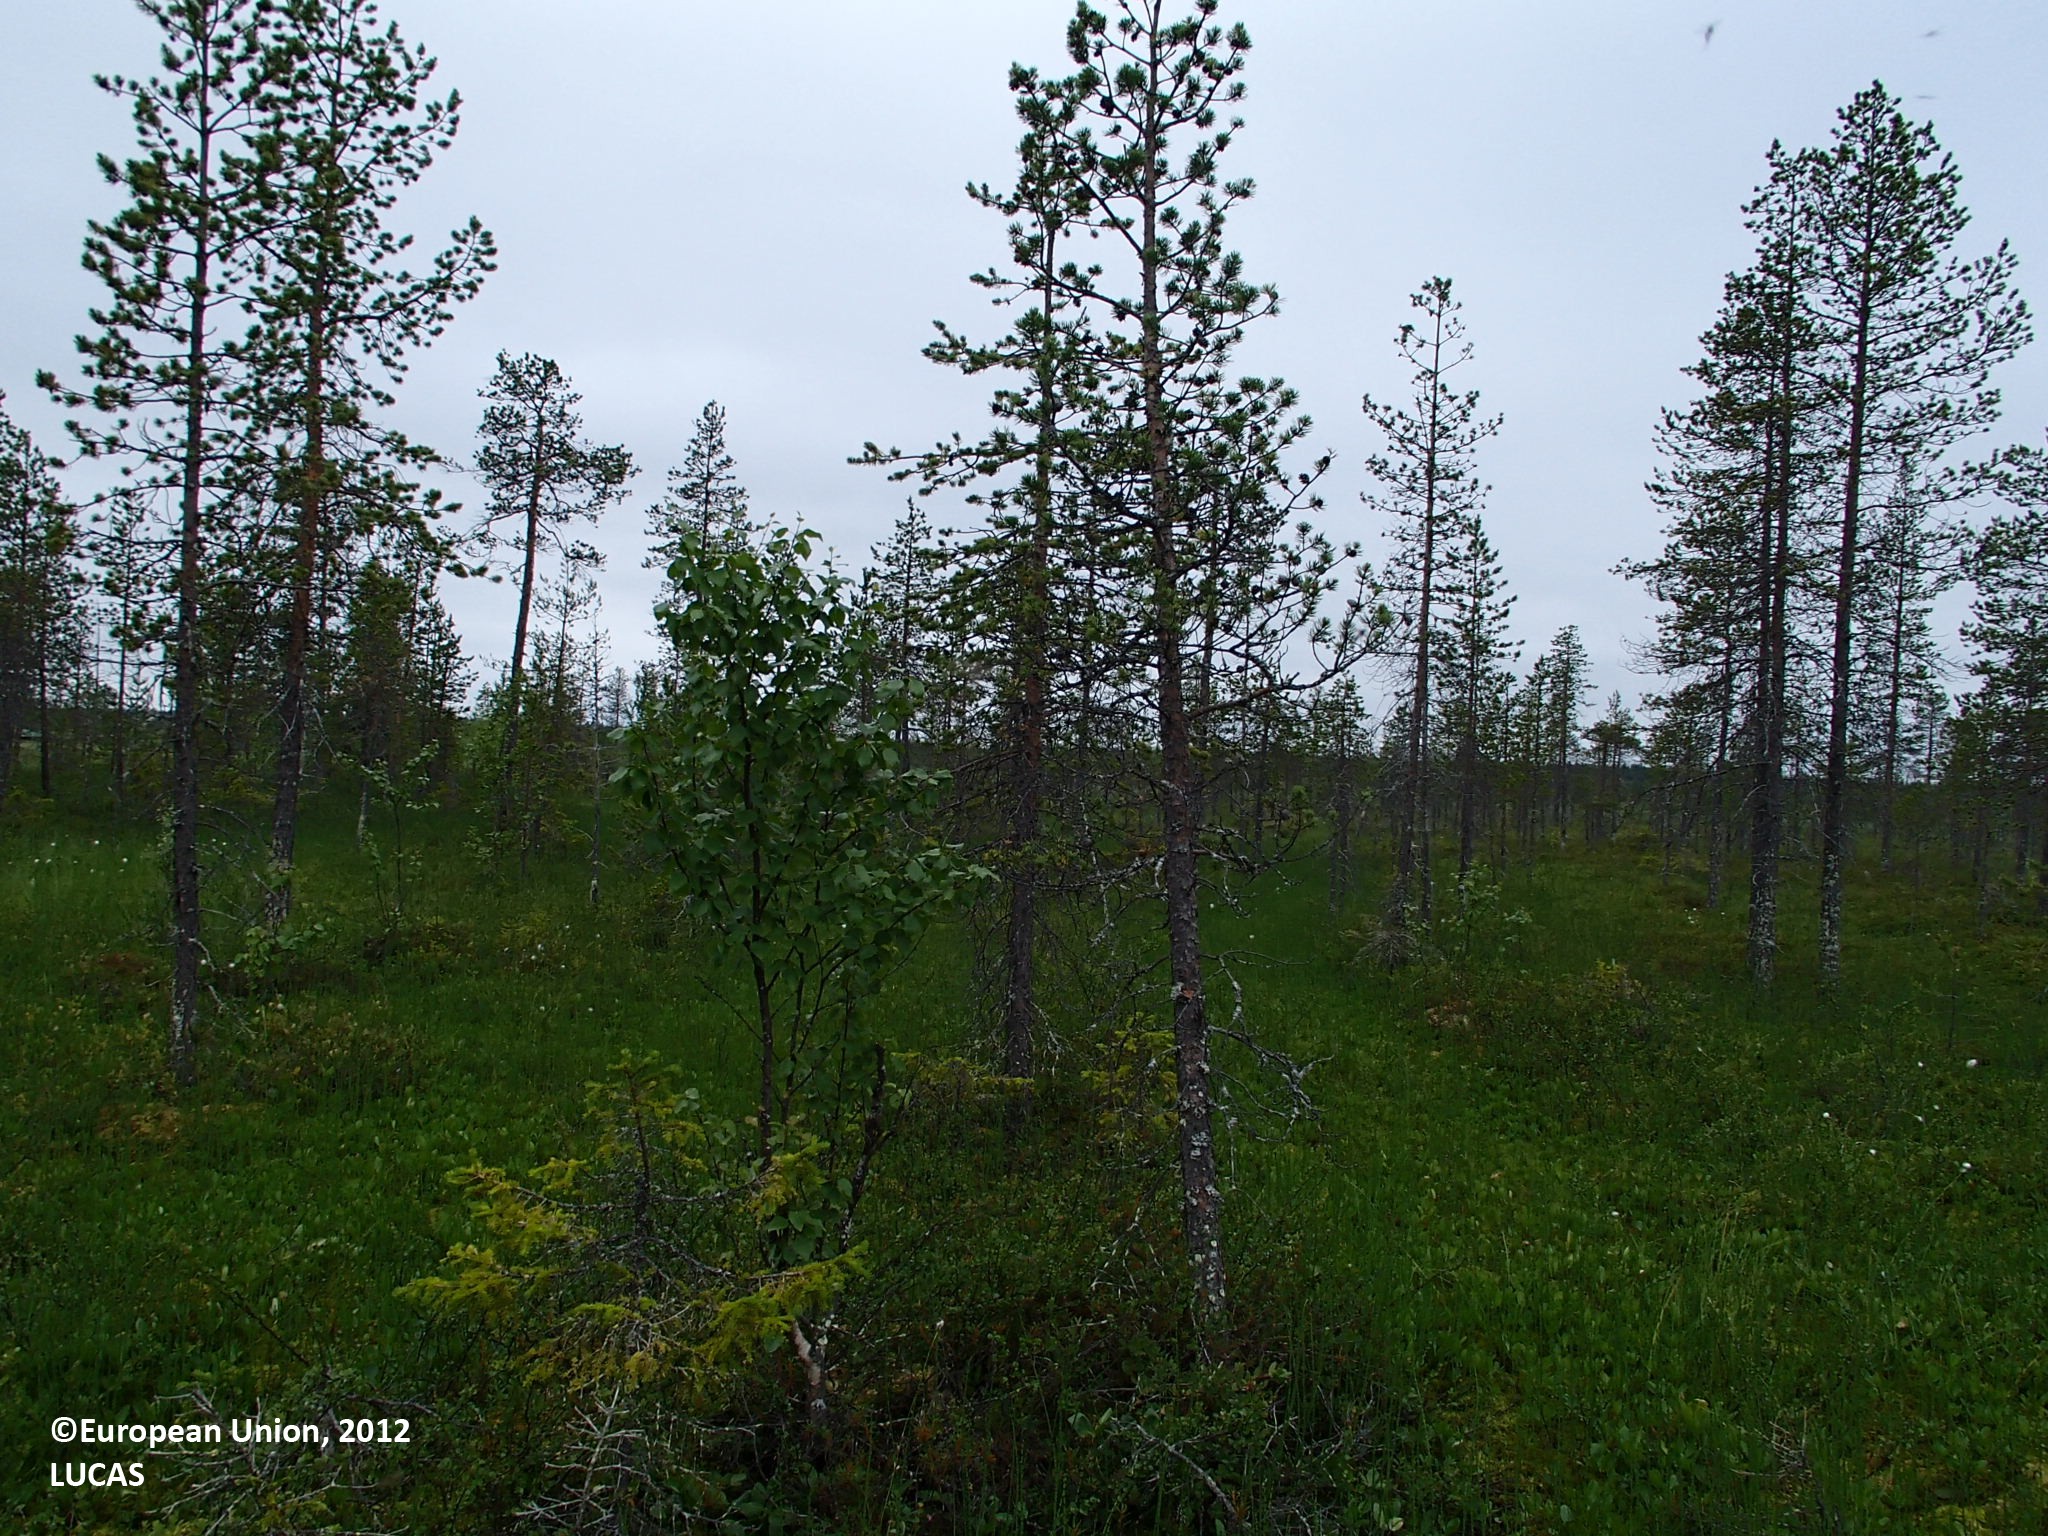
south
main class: Woodland
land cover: Pine dominated coniferous woodland
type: boreal forest
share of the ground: 10 - 25 %
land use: Forestry
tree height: > 5 m
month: July
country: FI
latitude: 67.3488
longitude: 25.9534
